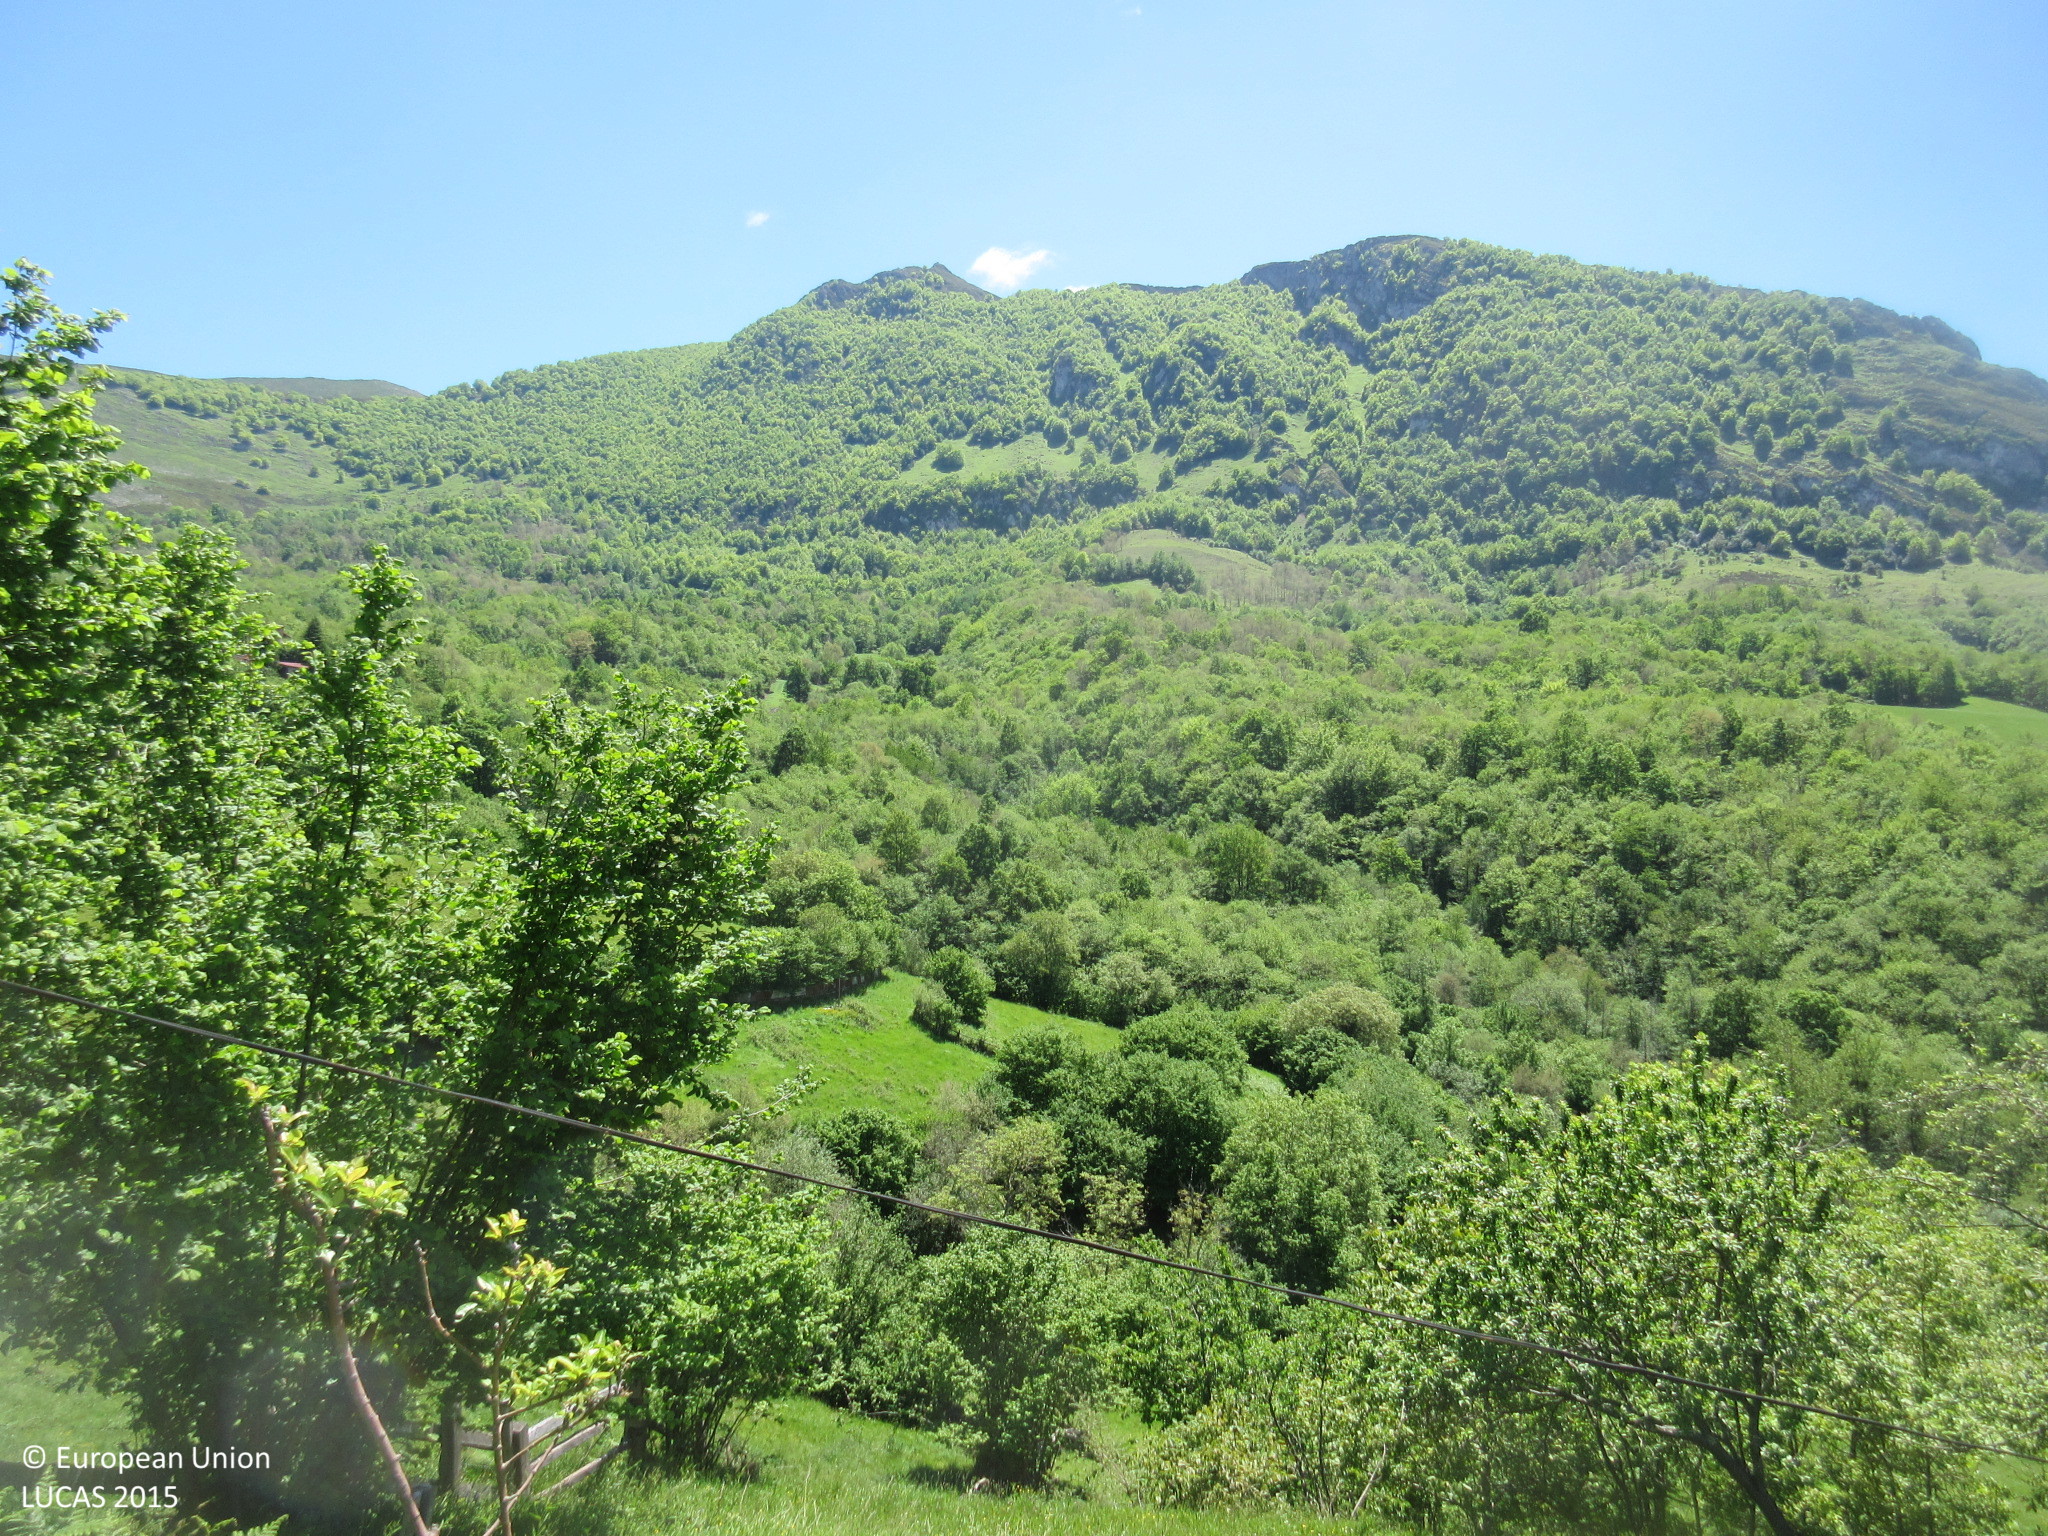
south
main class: Grassland
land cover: Grassland without tree/shrub cover
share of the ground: > 75 %
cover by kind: herbaceous plants 100 %
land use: Agriculture (excluding fallow land and kitchen gardens)
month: May
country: ES
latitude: 43.2035
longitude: -5.4492
